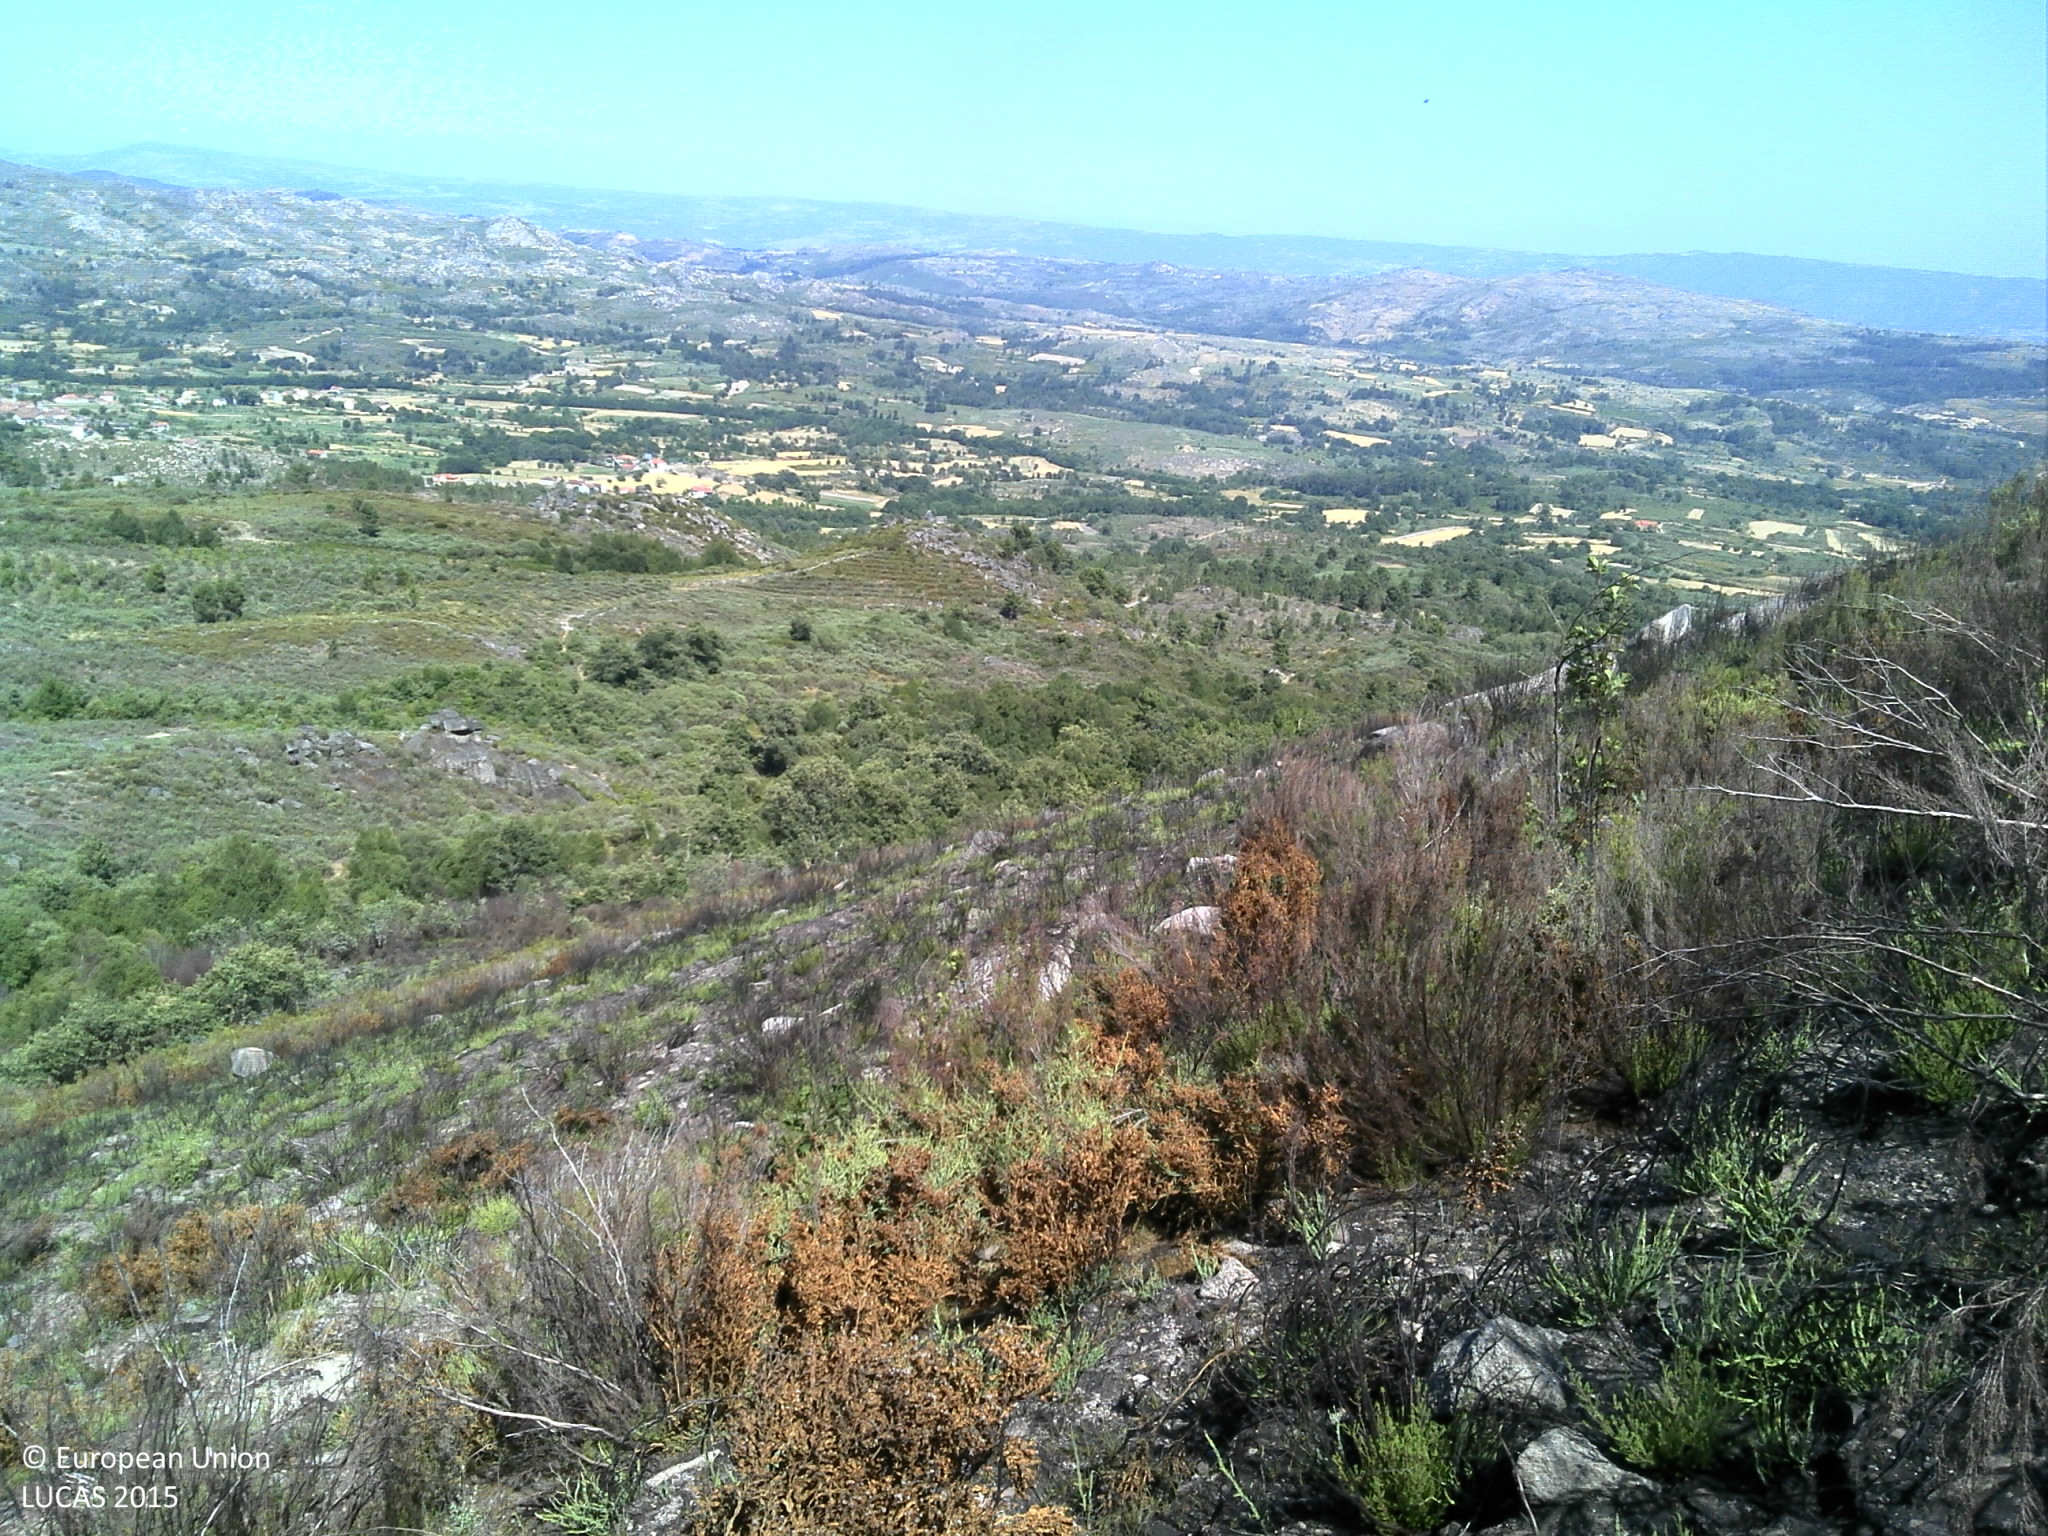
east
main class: Shrubland
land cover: Shrubland without tree cover
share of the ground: 25 - 50 %
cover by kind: unconsolidated bare surface 60 %, shrubs 30 %, herbaceous plants 5 %, consolidated bare surface 5 %
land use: Semi-natural and natural areas not in use
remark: Burnt area
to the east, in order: Shrubland without tree cover; Tracks; Shrubland without tree cover; Broadleaved woodland
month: July
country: PT
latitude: 41.7563
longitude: -7.6341
